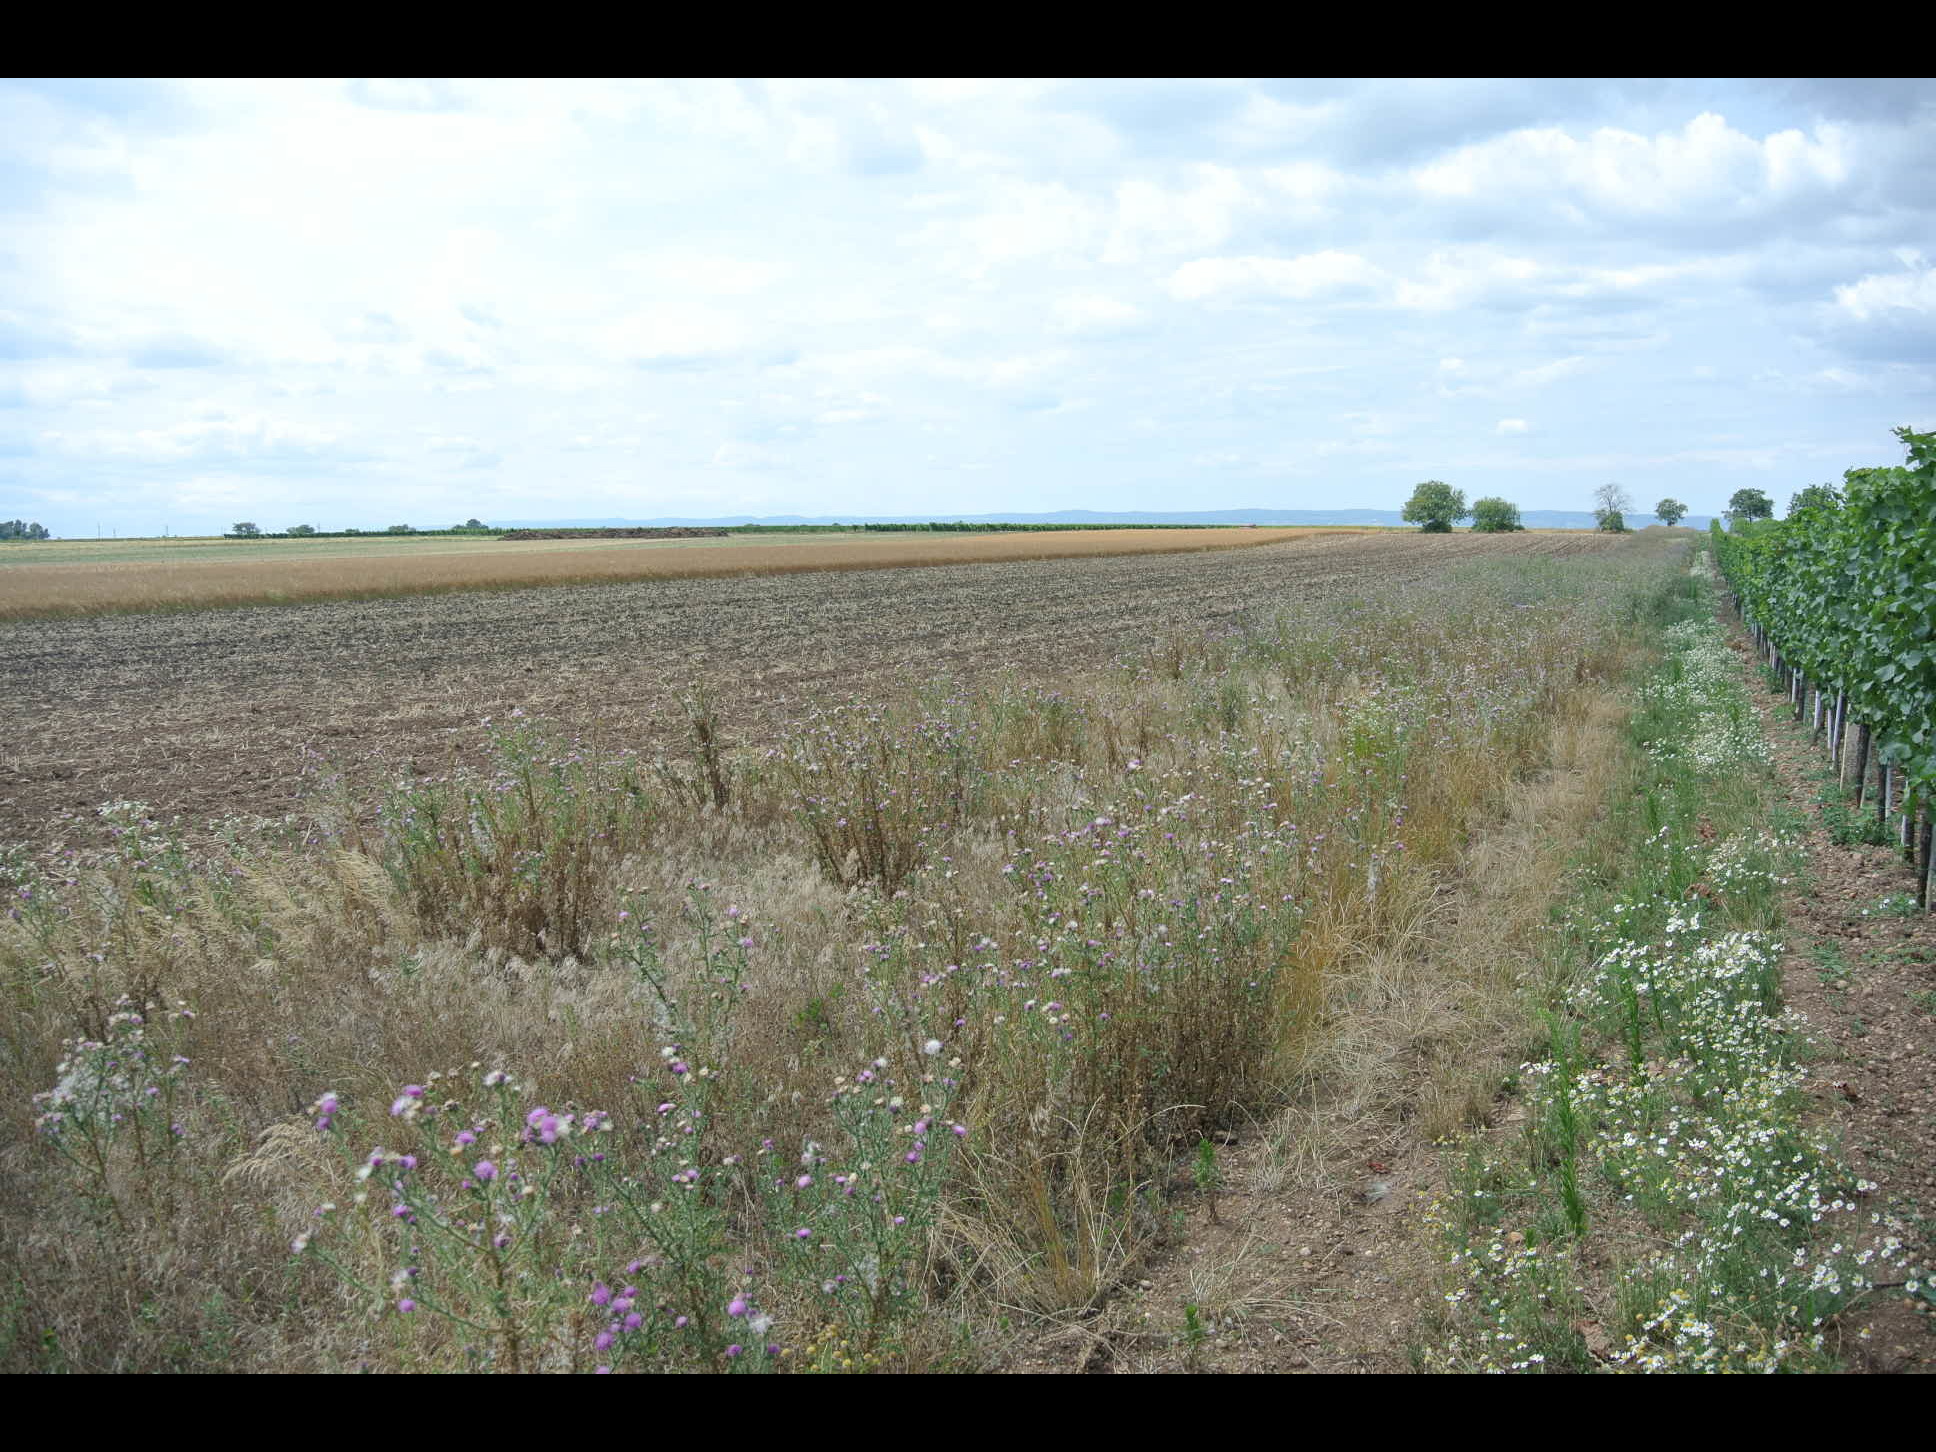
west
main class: Cropland
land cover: Vineyards
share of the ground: 25 - 50 %
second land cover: Spontaneously vegetated surfaces
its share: > 75 %
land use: Agriculture (excluding fallow land and kitchen gardens)
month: July
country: AT
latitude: 47.8455
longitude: 16.8881
